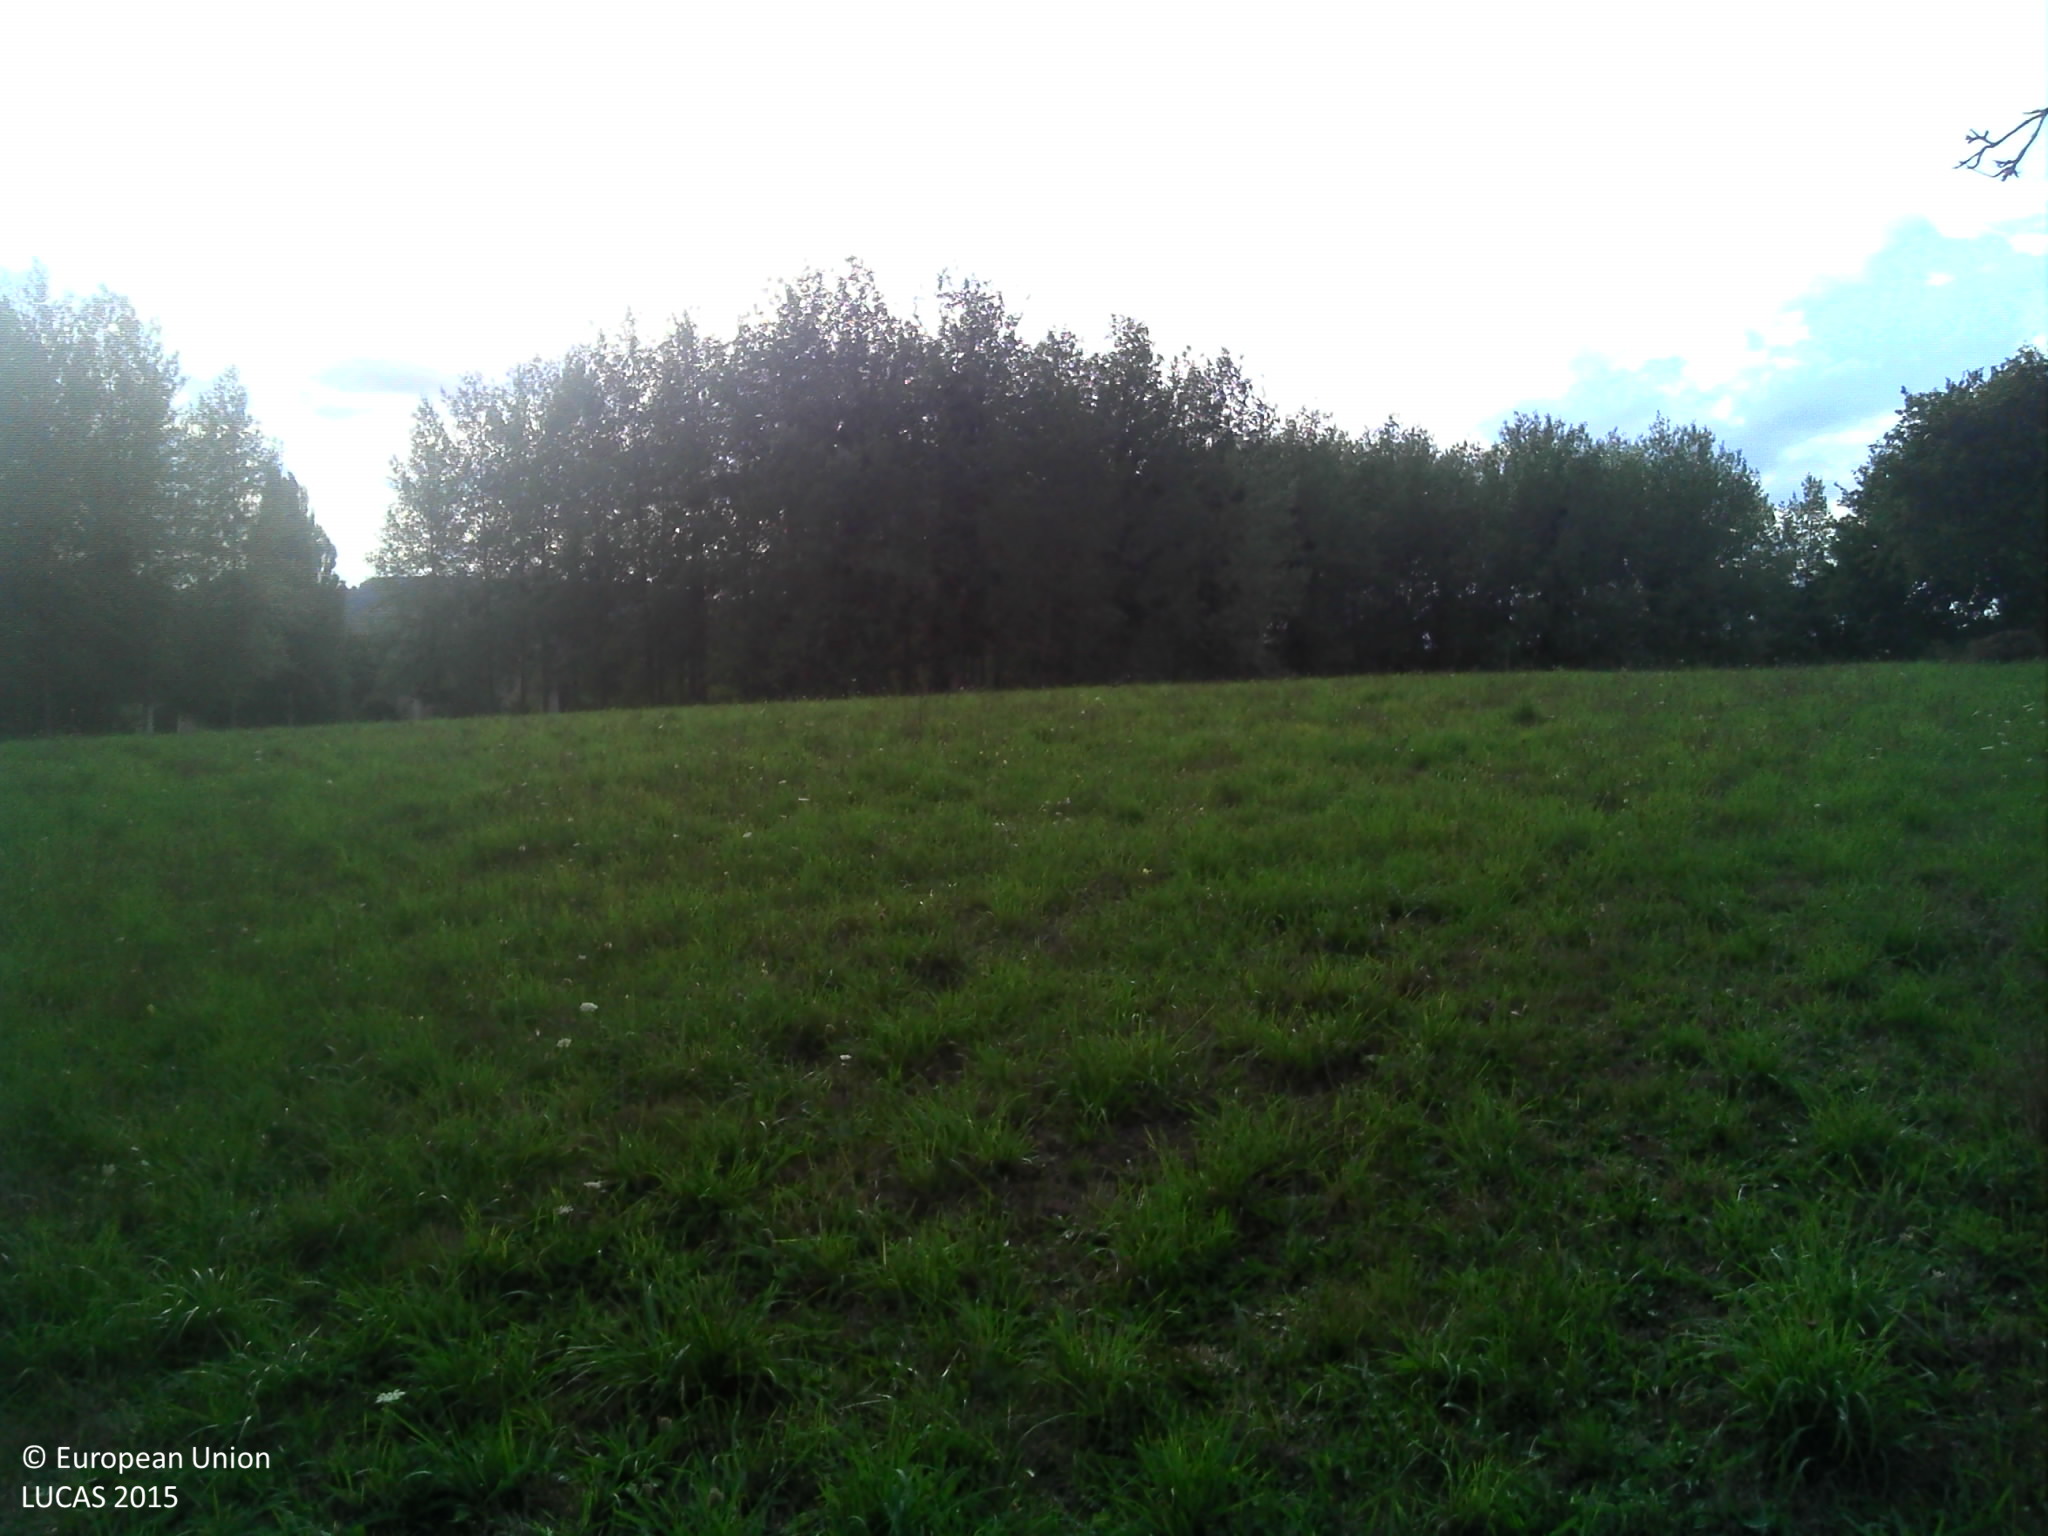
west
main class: Grassland
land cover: Grassland without tree/shrub cover
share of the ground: > 75 %
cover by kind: herbaceous plants 100 %
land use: Agriculture (excluding fallow land and kitchen gardens)
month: September
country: FR
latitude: 48.4201
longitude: 0.8303
